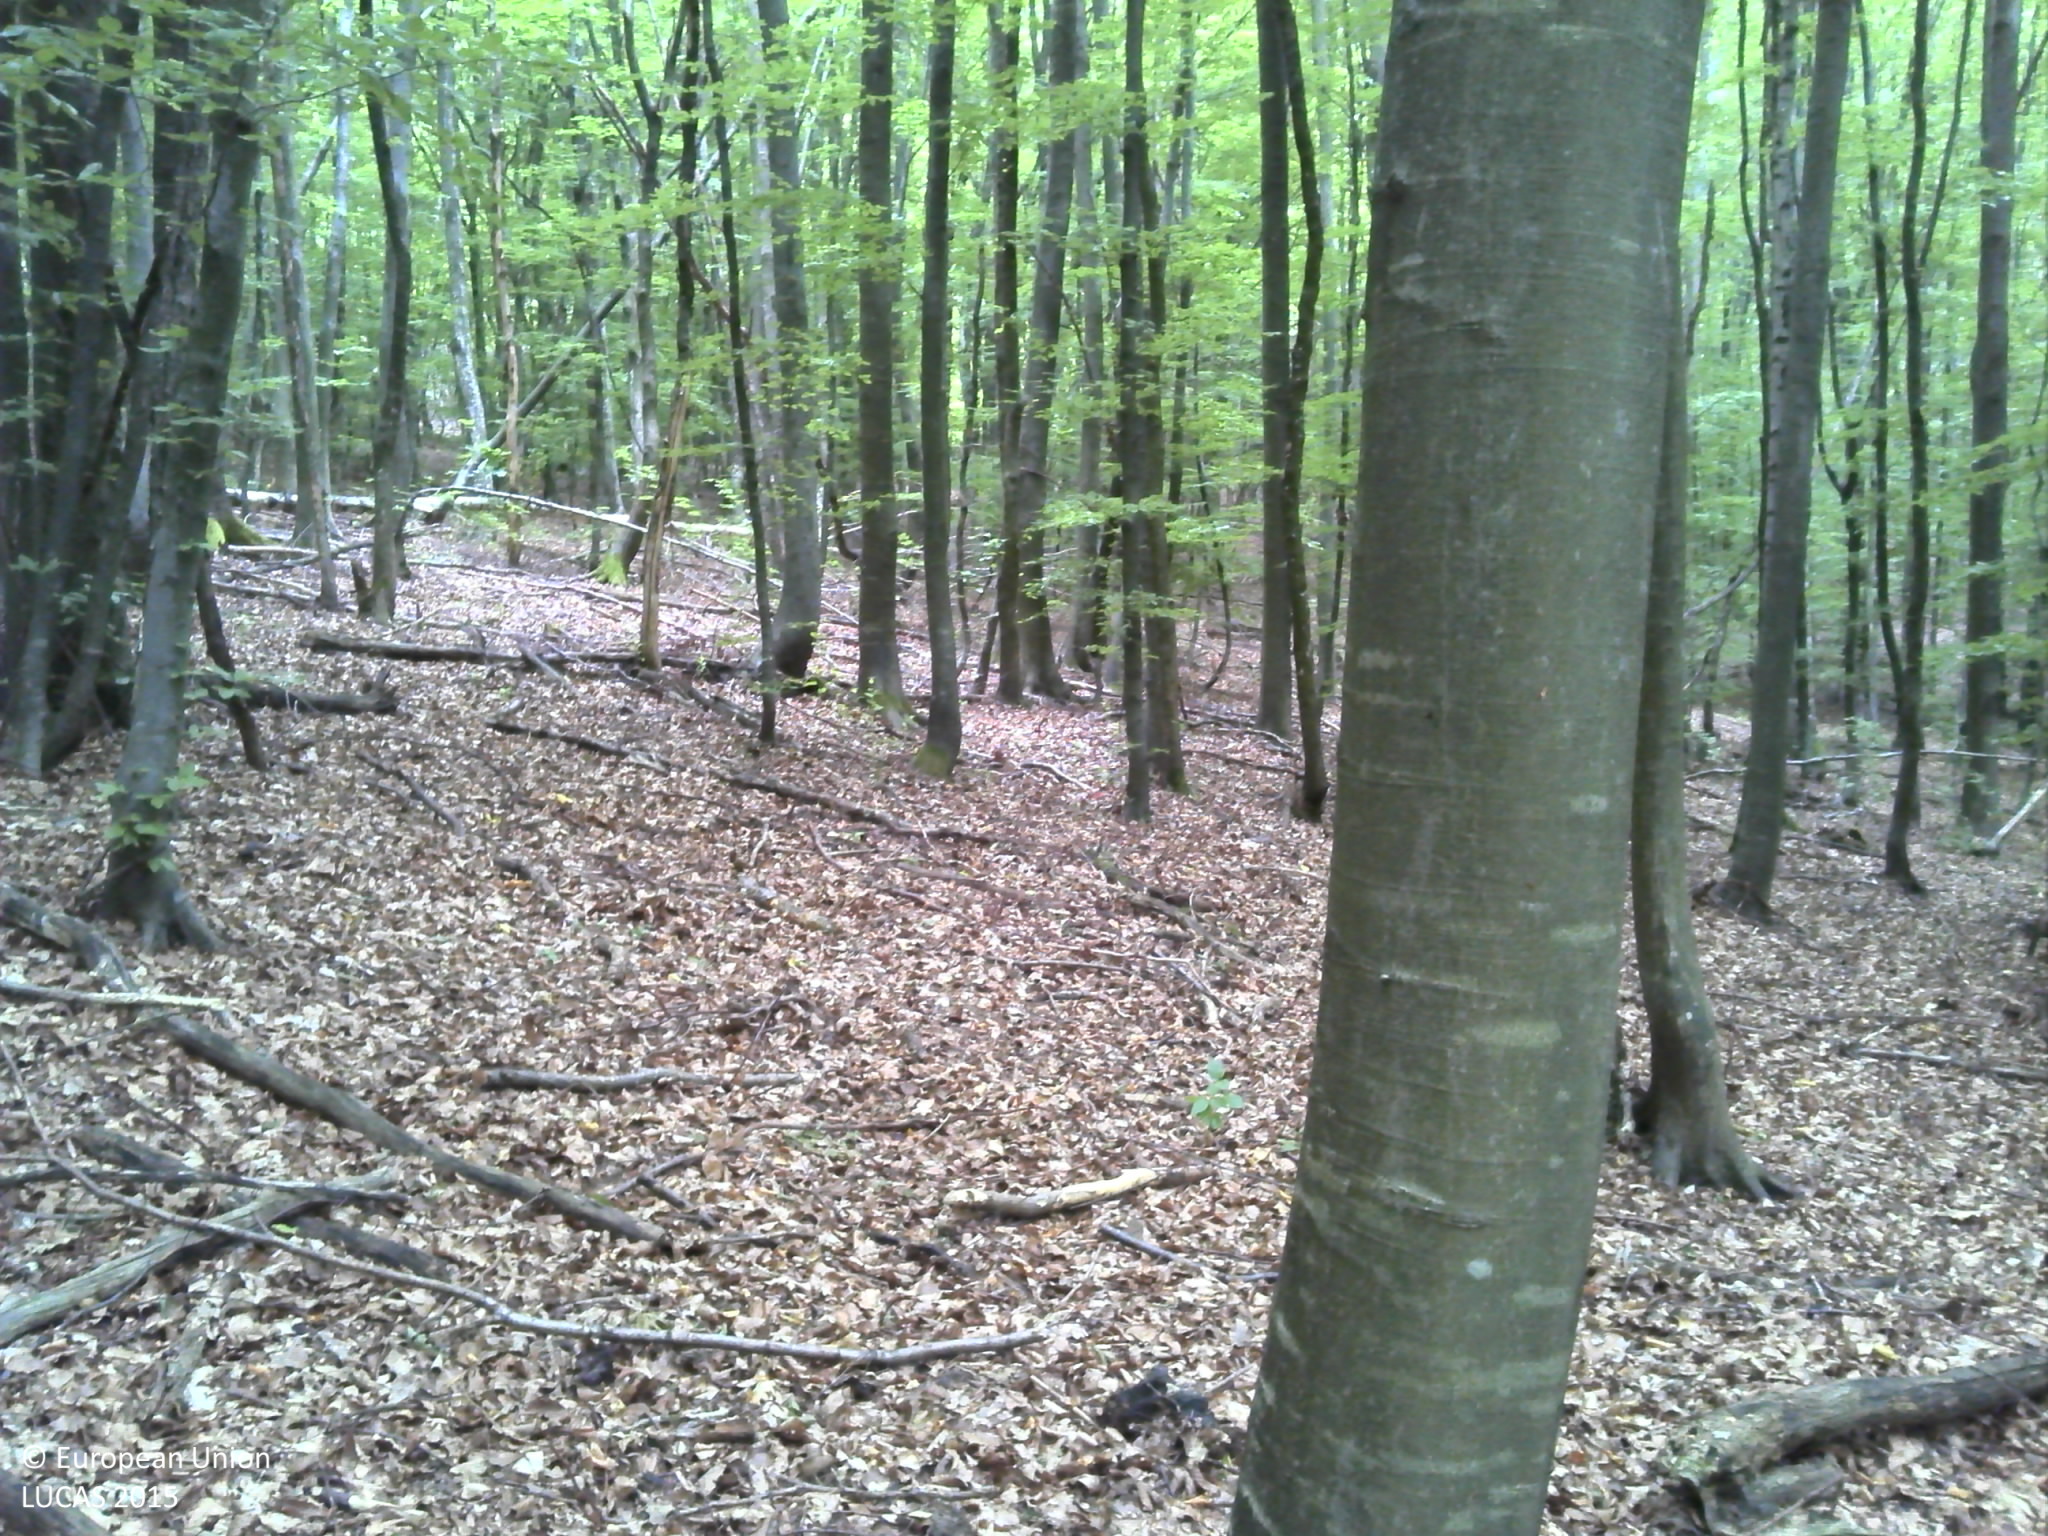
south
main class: Woodland
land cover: Broadleaved woodland
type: beech forest
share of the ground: > 75 %
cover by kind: broadleaved forest trees 80 %, lichens and mosses 20 %
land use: Forestry
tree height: > 5 m
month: June
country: HR
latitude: 45.4738
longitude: 17.4845
